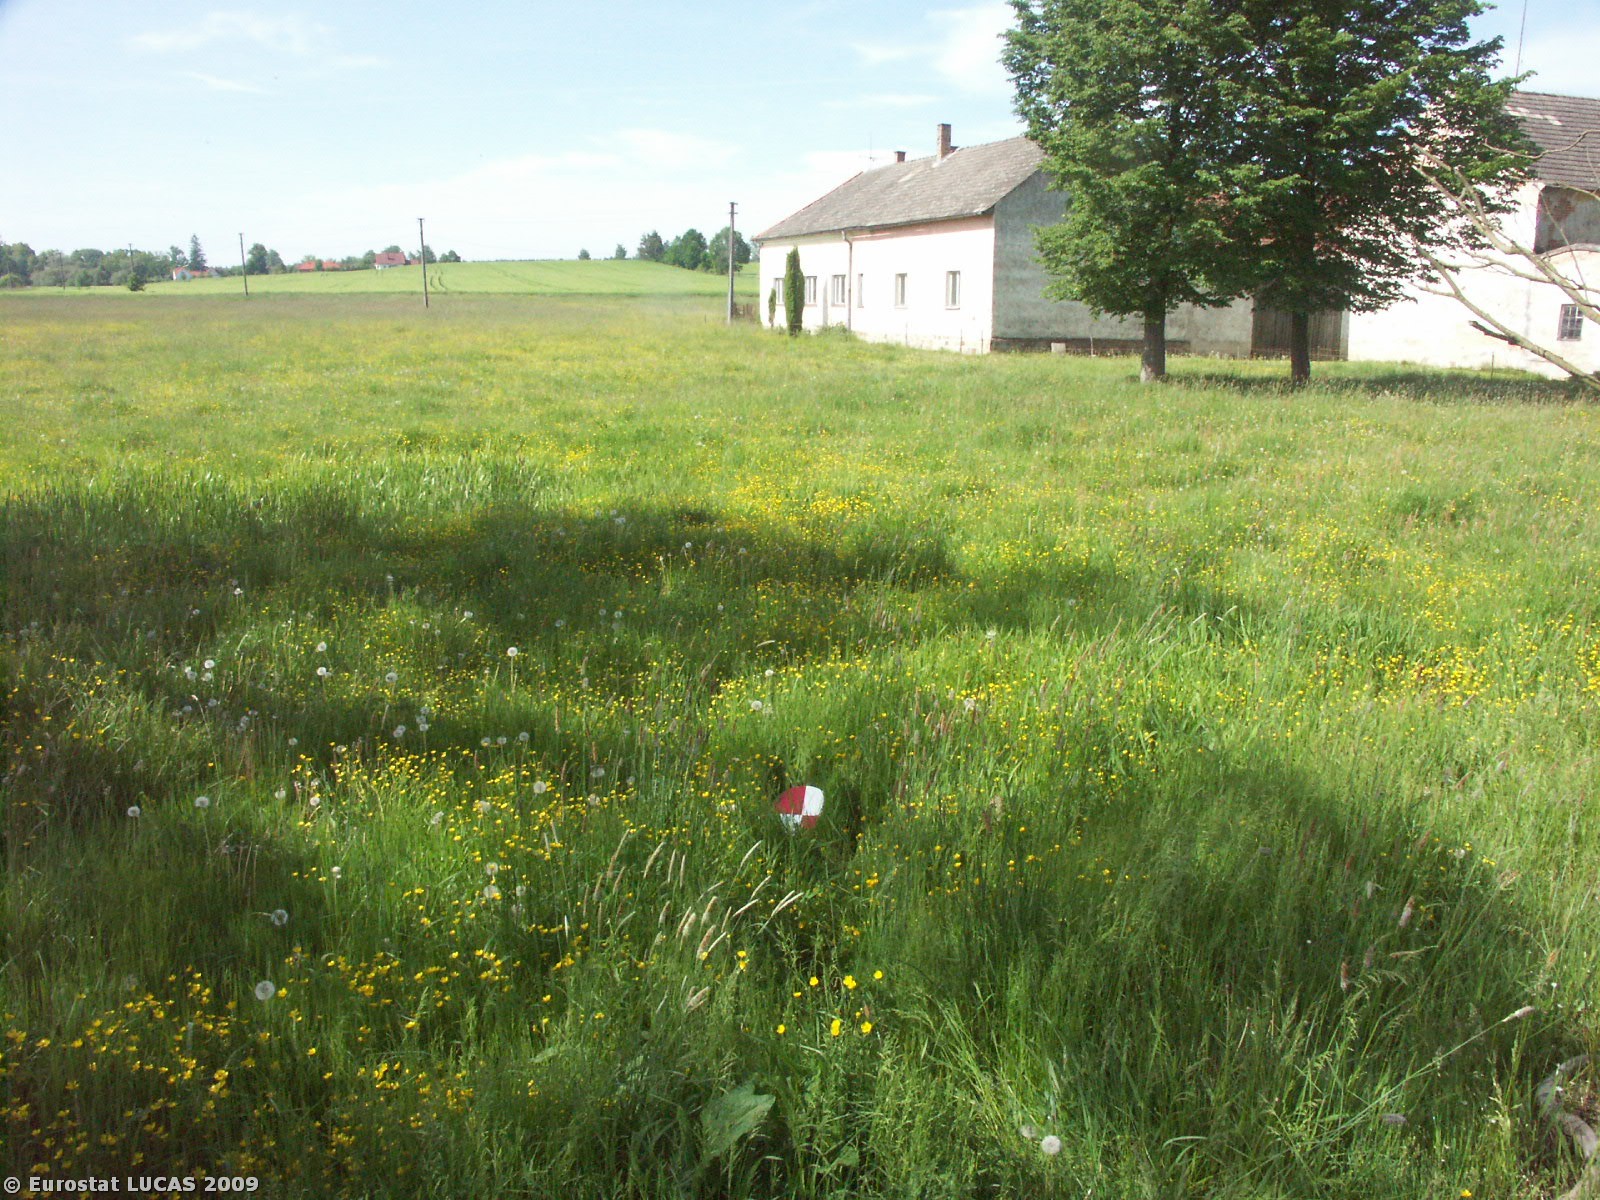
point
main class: Woodland
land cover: Broadleaved woodland
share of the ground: > 75 %
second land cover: Grassland with sparse tree/shrub cover
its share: > 75 %
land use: Nature reserves
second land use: Agriculture (excluding fallow land and kitchen gardens)
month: May
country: CZ
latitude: 48.8812
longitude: 14.6786
